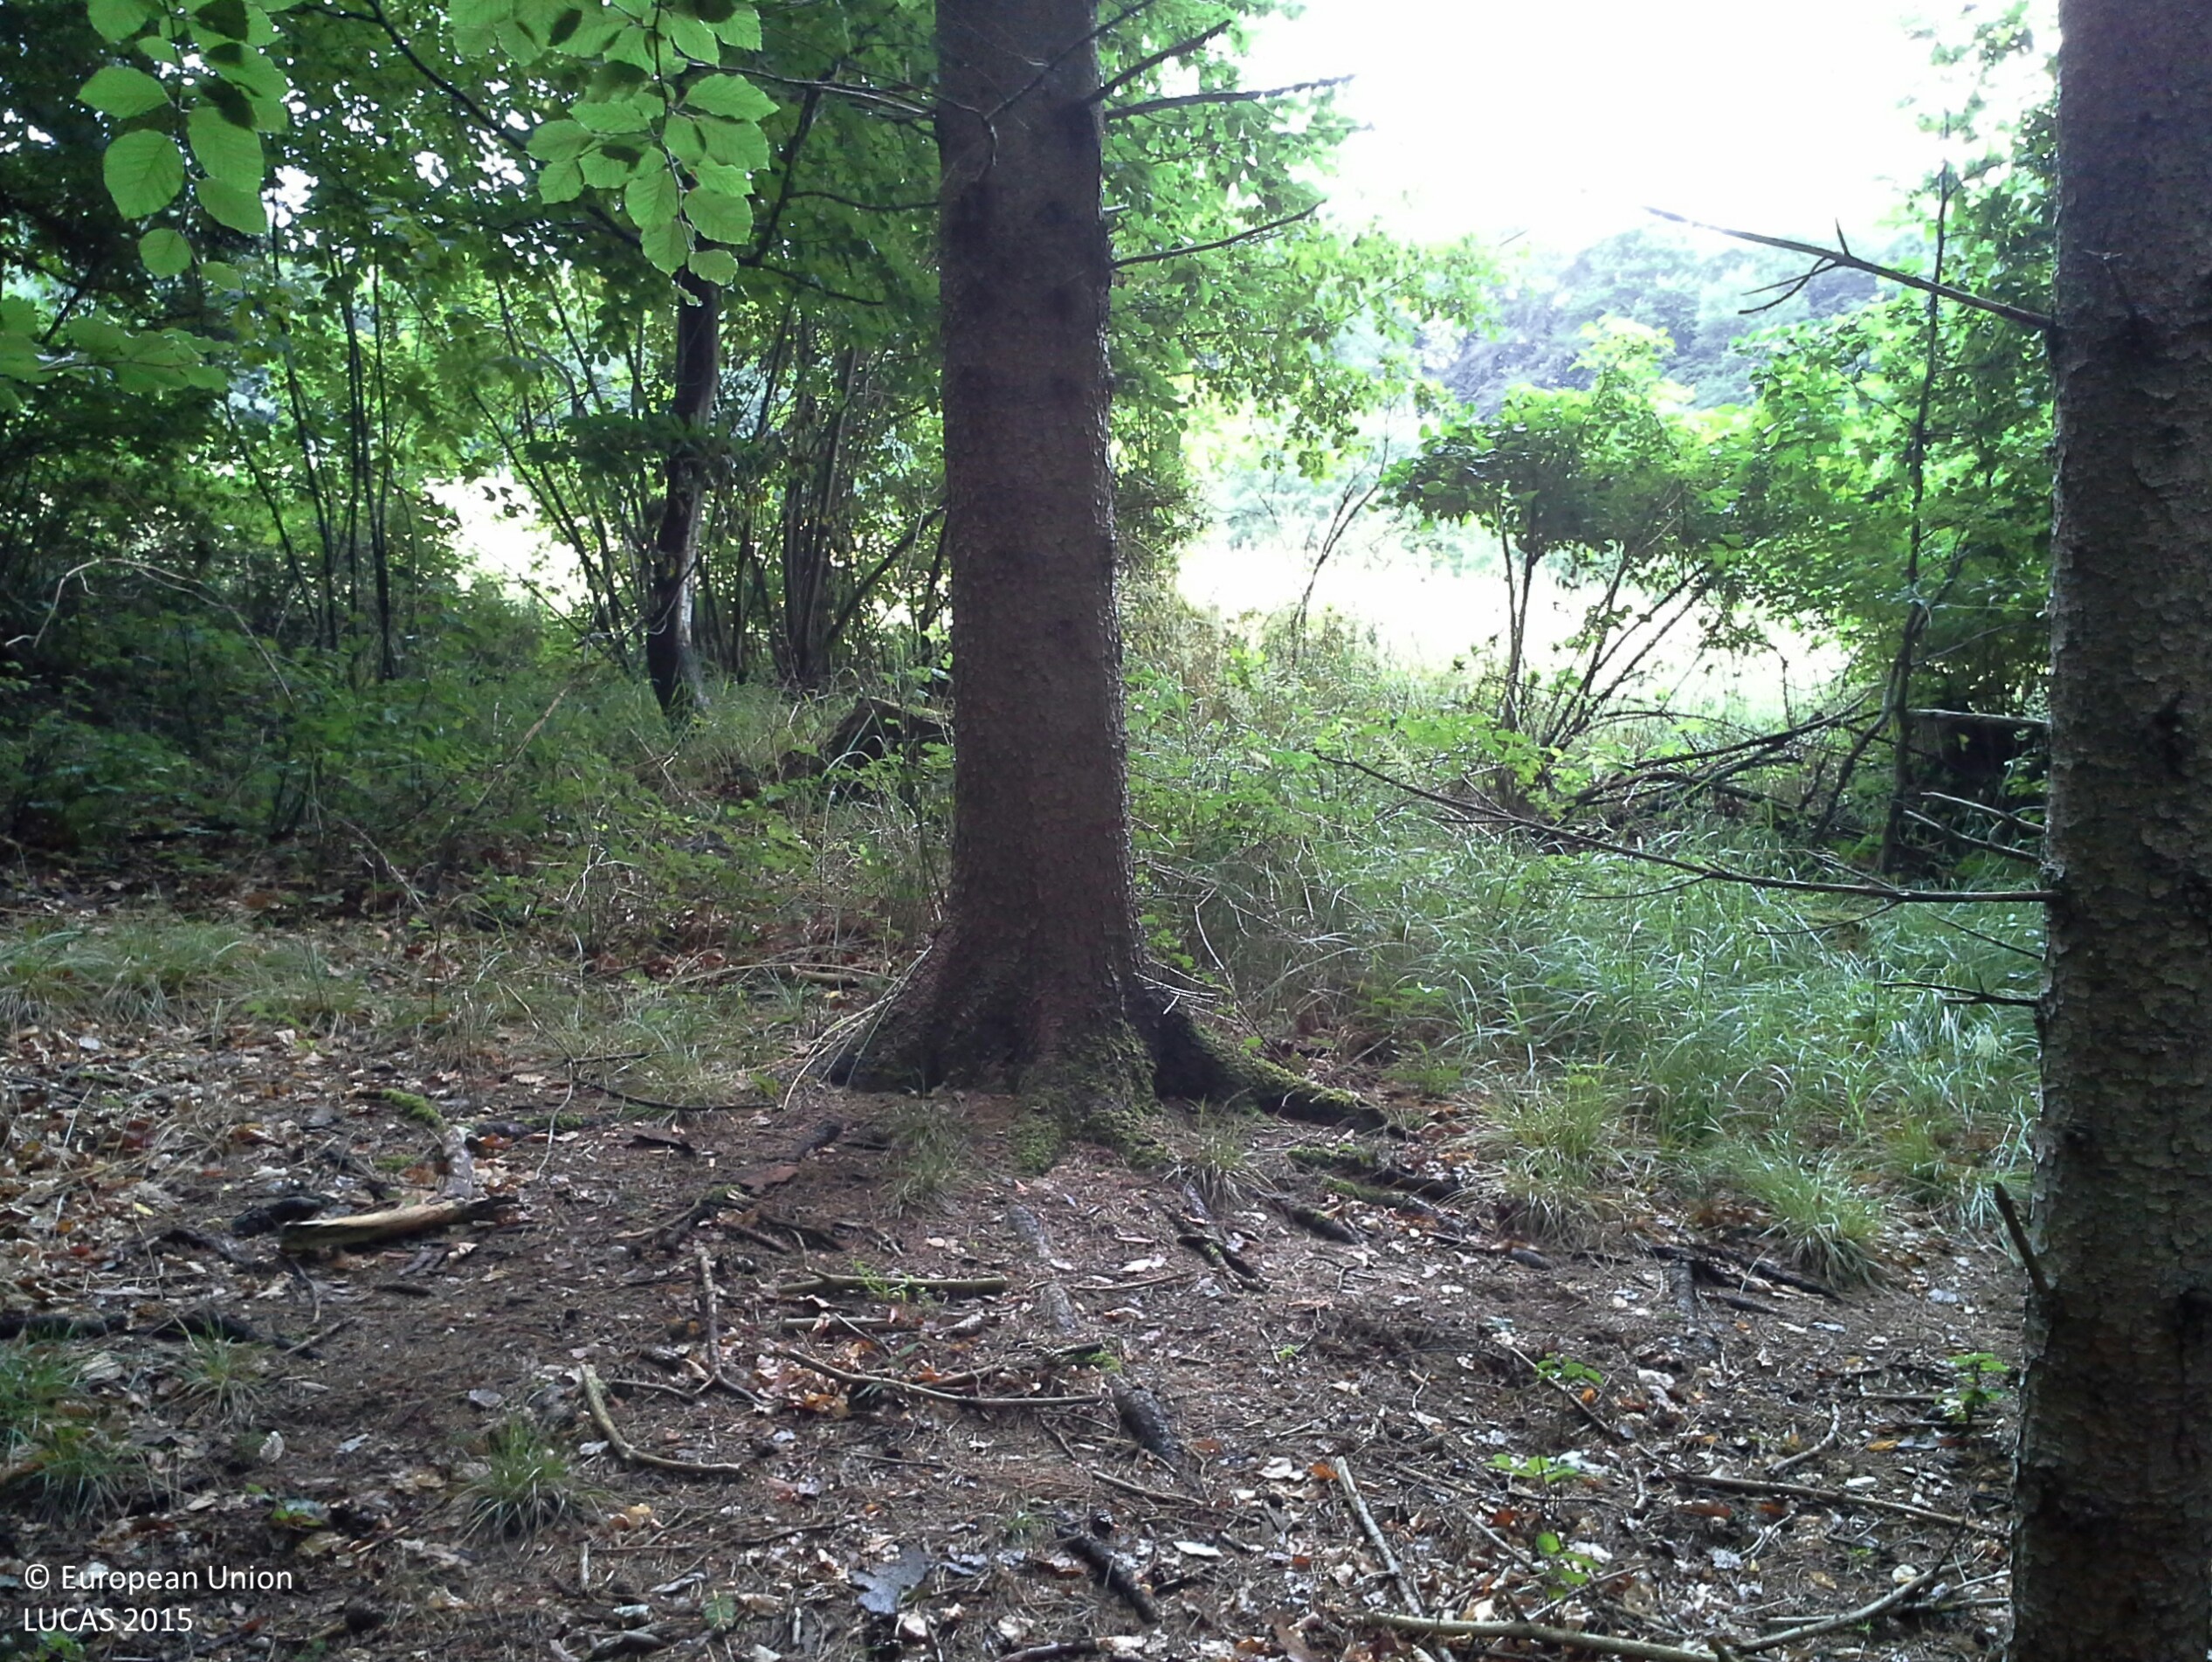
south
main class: Woodland
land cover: Spruce dominated mixed woodland
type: beech forest
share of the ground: > 75 %
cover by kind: coniferous forest trees 50 %, broadleaved forest trees 35 %, consolidated bare surface 10 %, herbaceous plants 5 %
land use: Forestry
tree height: > 5 m
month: July
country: AT
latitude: 48.0462
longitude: 14.8164
